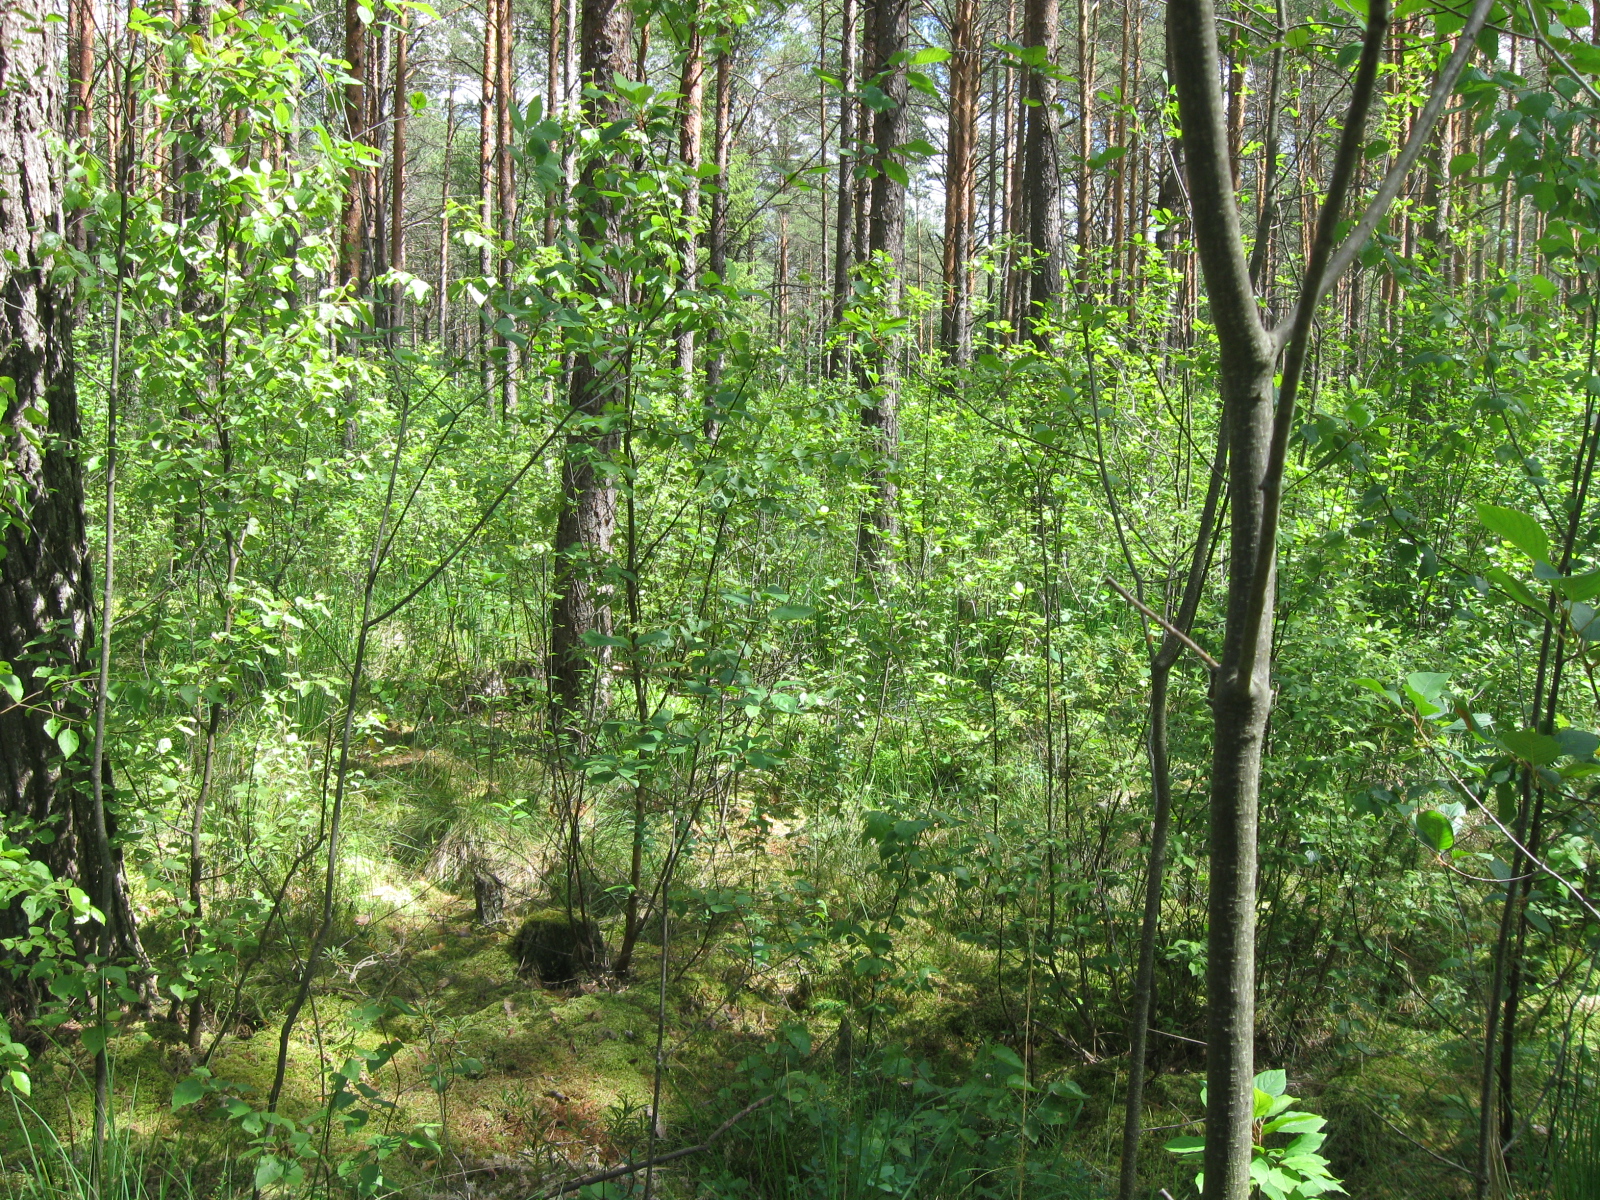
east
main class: Woodland
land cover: Pine dominated mixed woodland
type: mire and swamp forests
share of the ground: > 75 %
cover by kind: coniferous forest trees 55 %, broadleaved forest trees 30 %, herbaceous plants 15 %
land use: Forestry
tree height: > 5 m
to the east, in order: Pine dominated mixed woodland; Ditches and canals; Pine dominated mixed woodland; Other mixed woodland; Broadleaved woodland
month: June
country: LT
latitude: 53.9807
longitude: 24.2336
